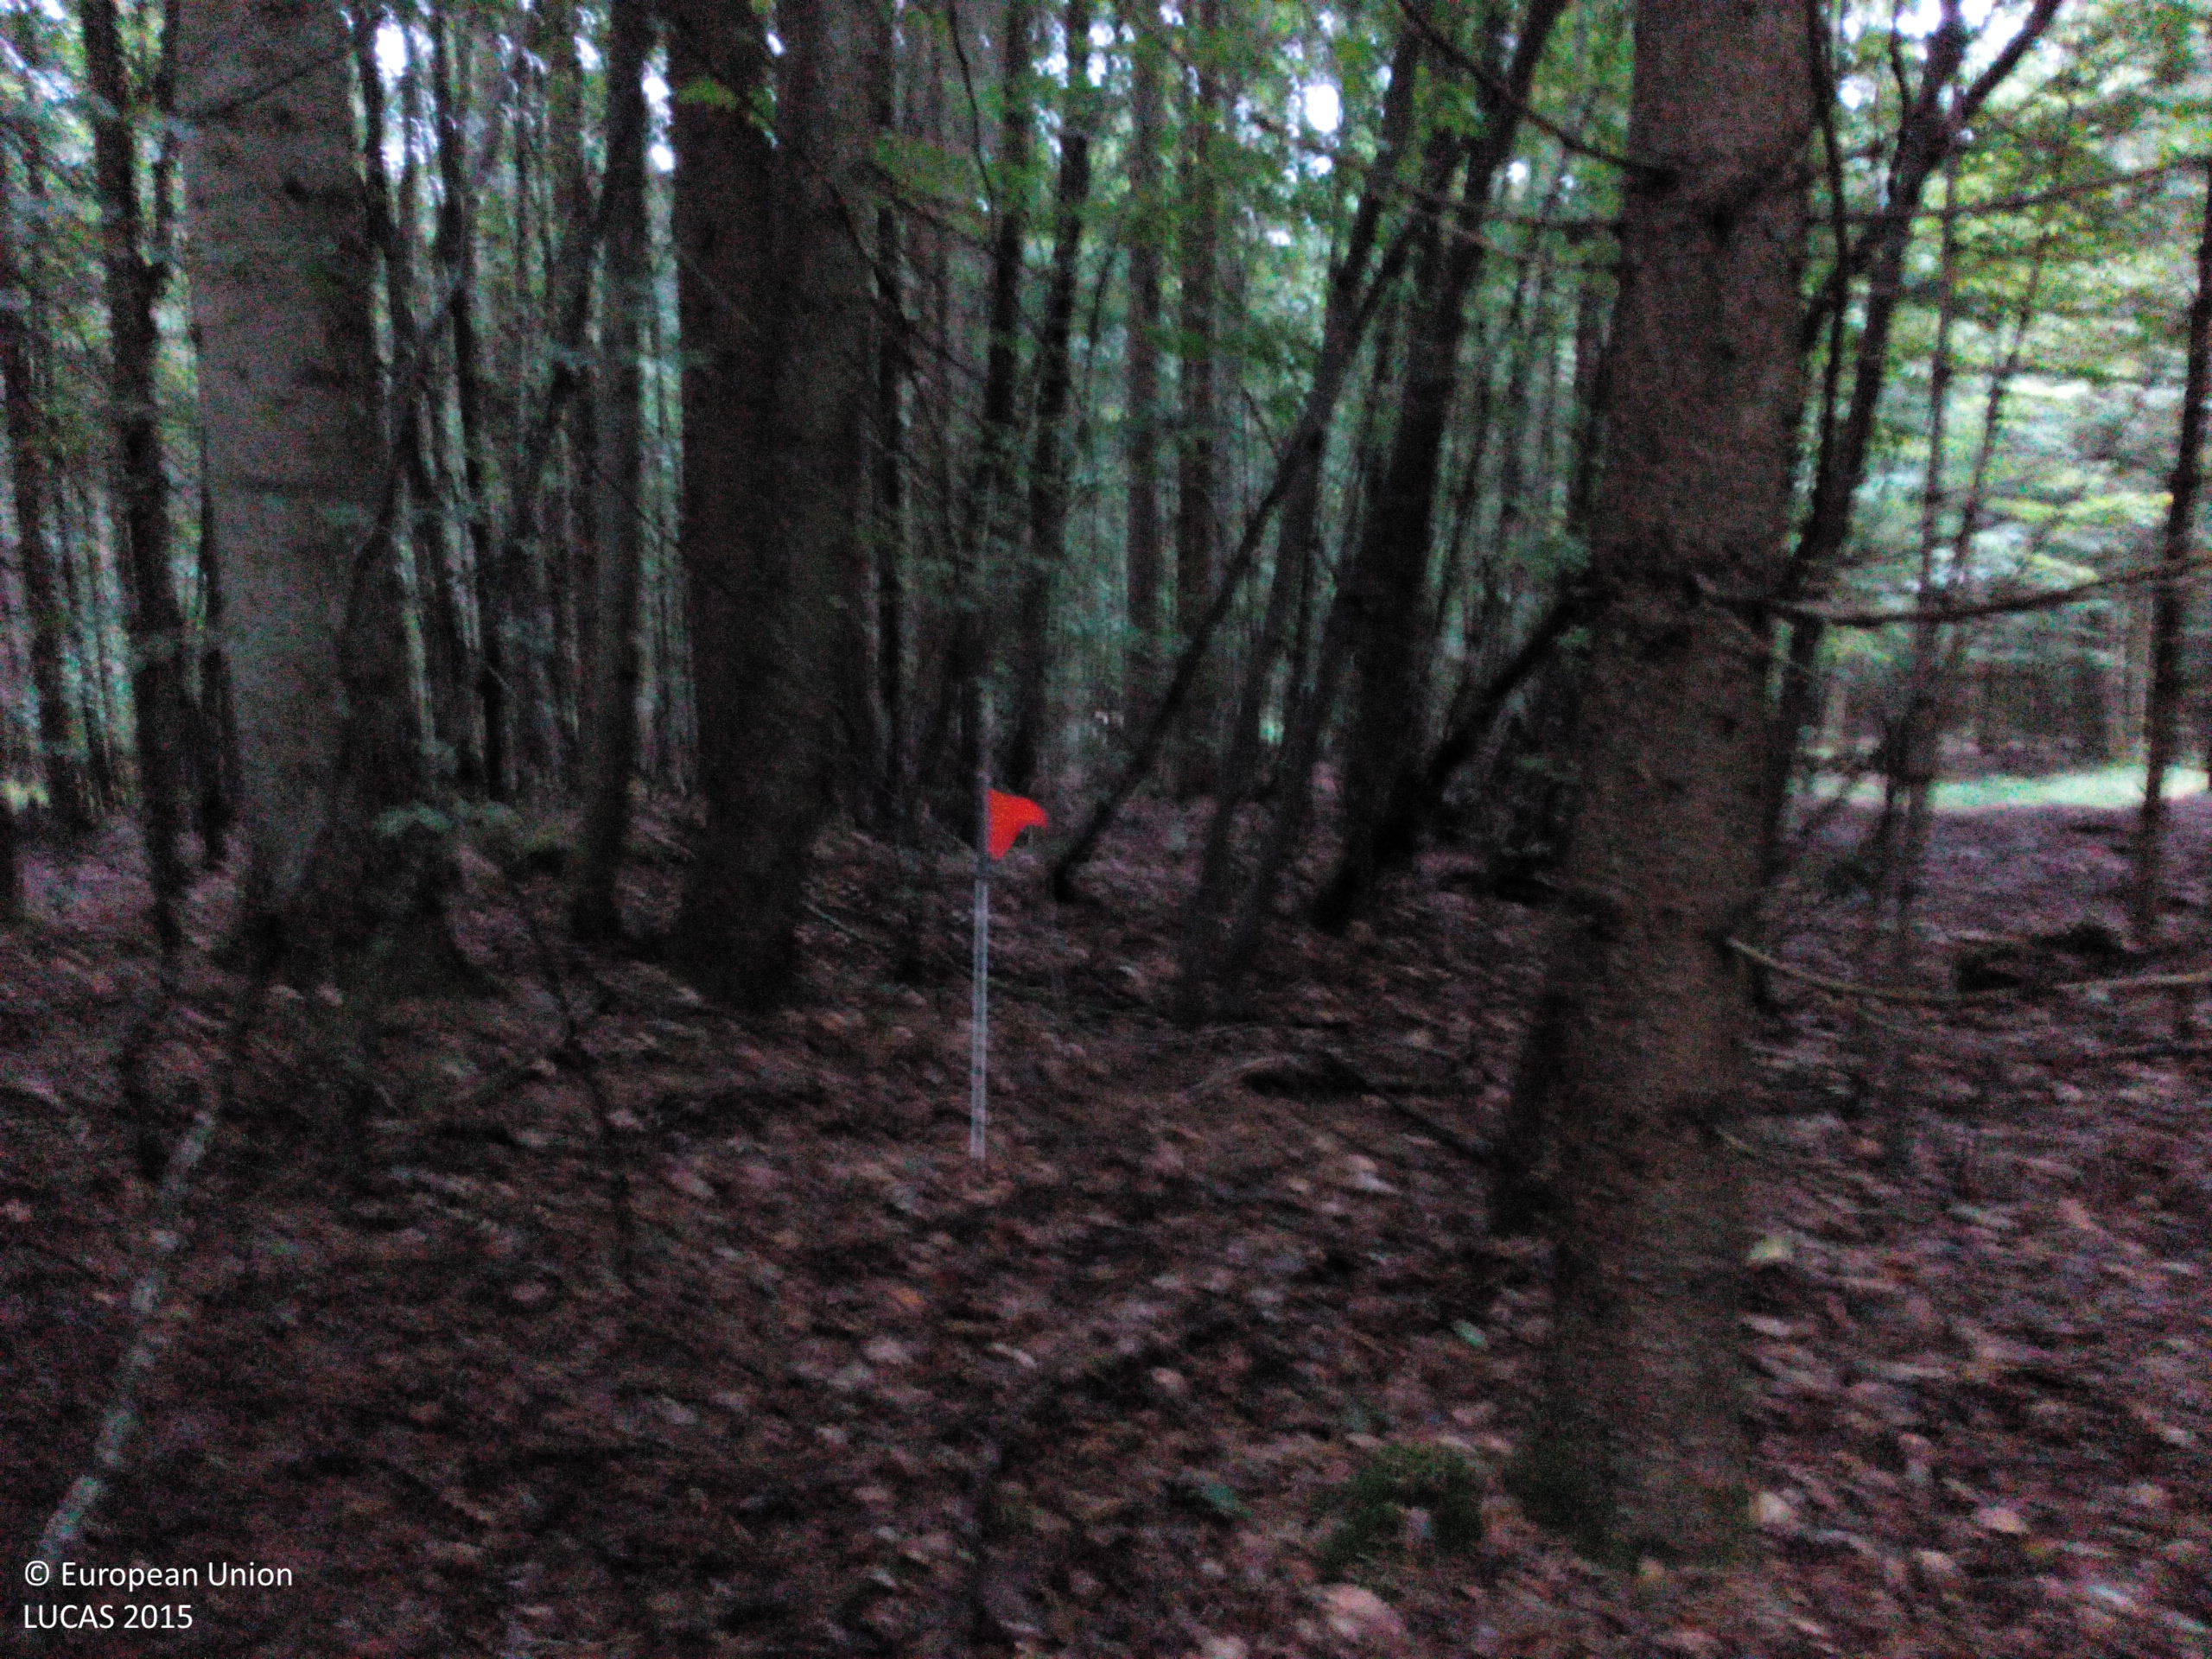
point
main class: Woodland
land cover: Spruce dominated mixed woodland
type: hemiboreal forest and nemoral coniferous forest and mixed broadleaved-coniferous forest
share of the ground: > 75 %
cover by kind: broadleaved forest trees 55 %, coniferous forest trees 40 %, unconsolidated bare surface 5 %
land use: Forestry
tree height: > 5 m
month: September
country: DE
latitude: 48.9675
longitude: 13.2644
